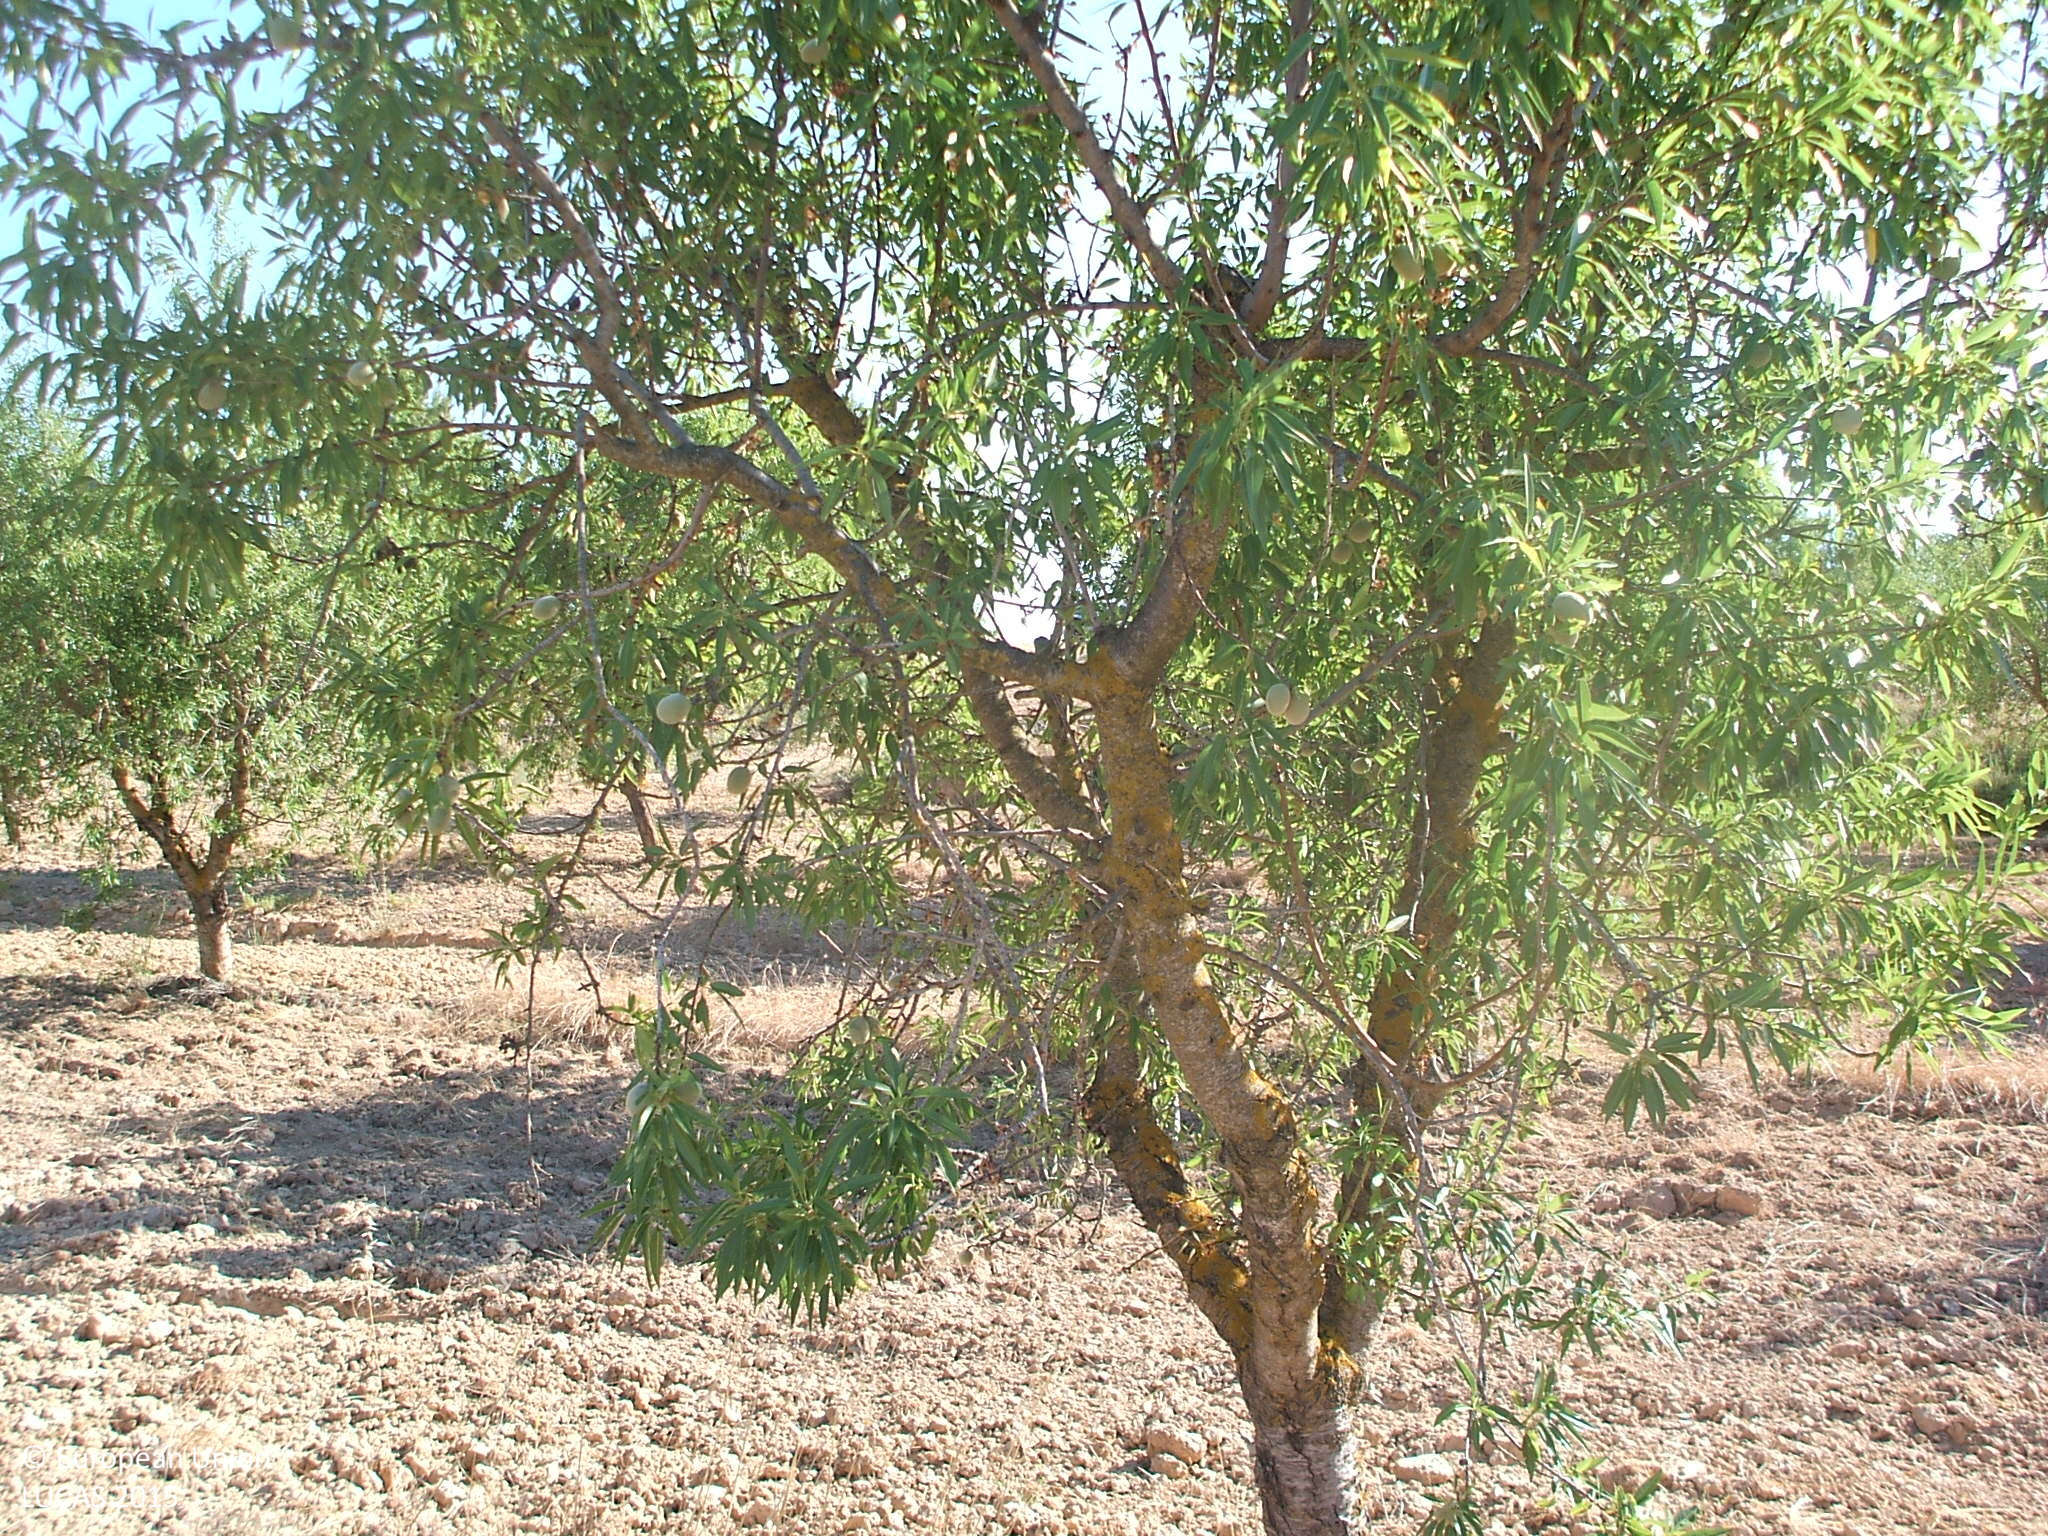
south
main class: Shrubland
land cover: Shrubland without tree cover
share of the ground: > 75 %
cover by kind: shrubs 100 %
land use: Agriculture (excluding fallow land and kitchen gardens)
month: June
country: ES
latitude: 41.0296
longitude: 0.1780
